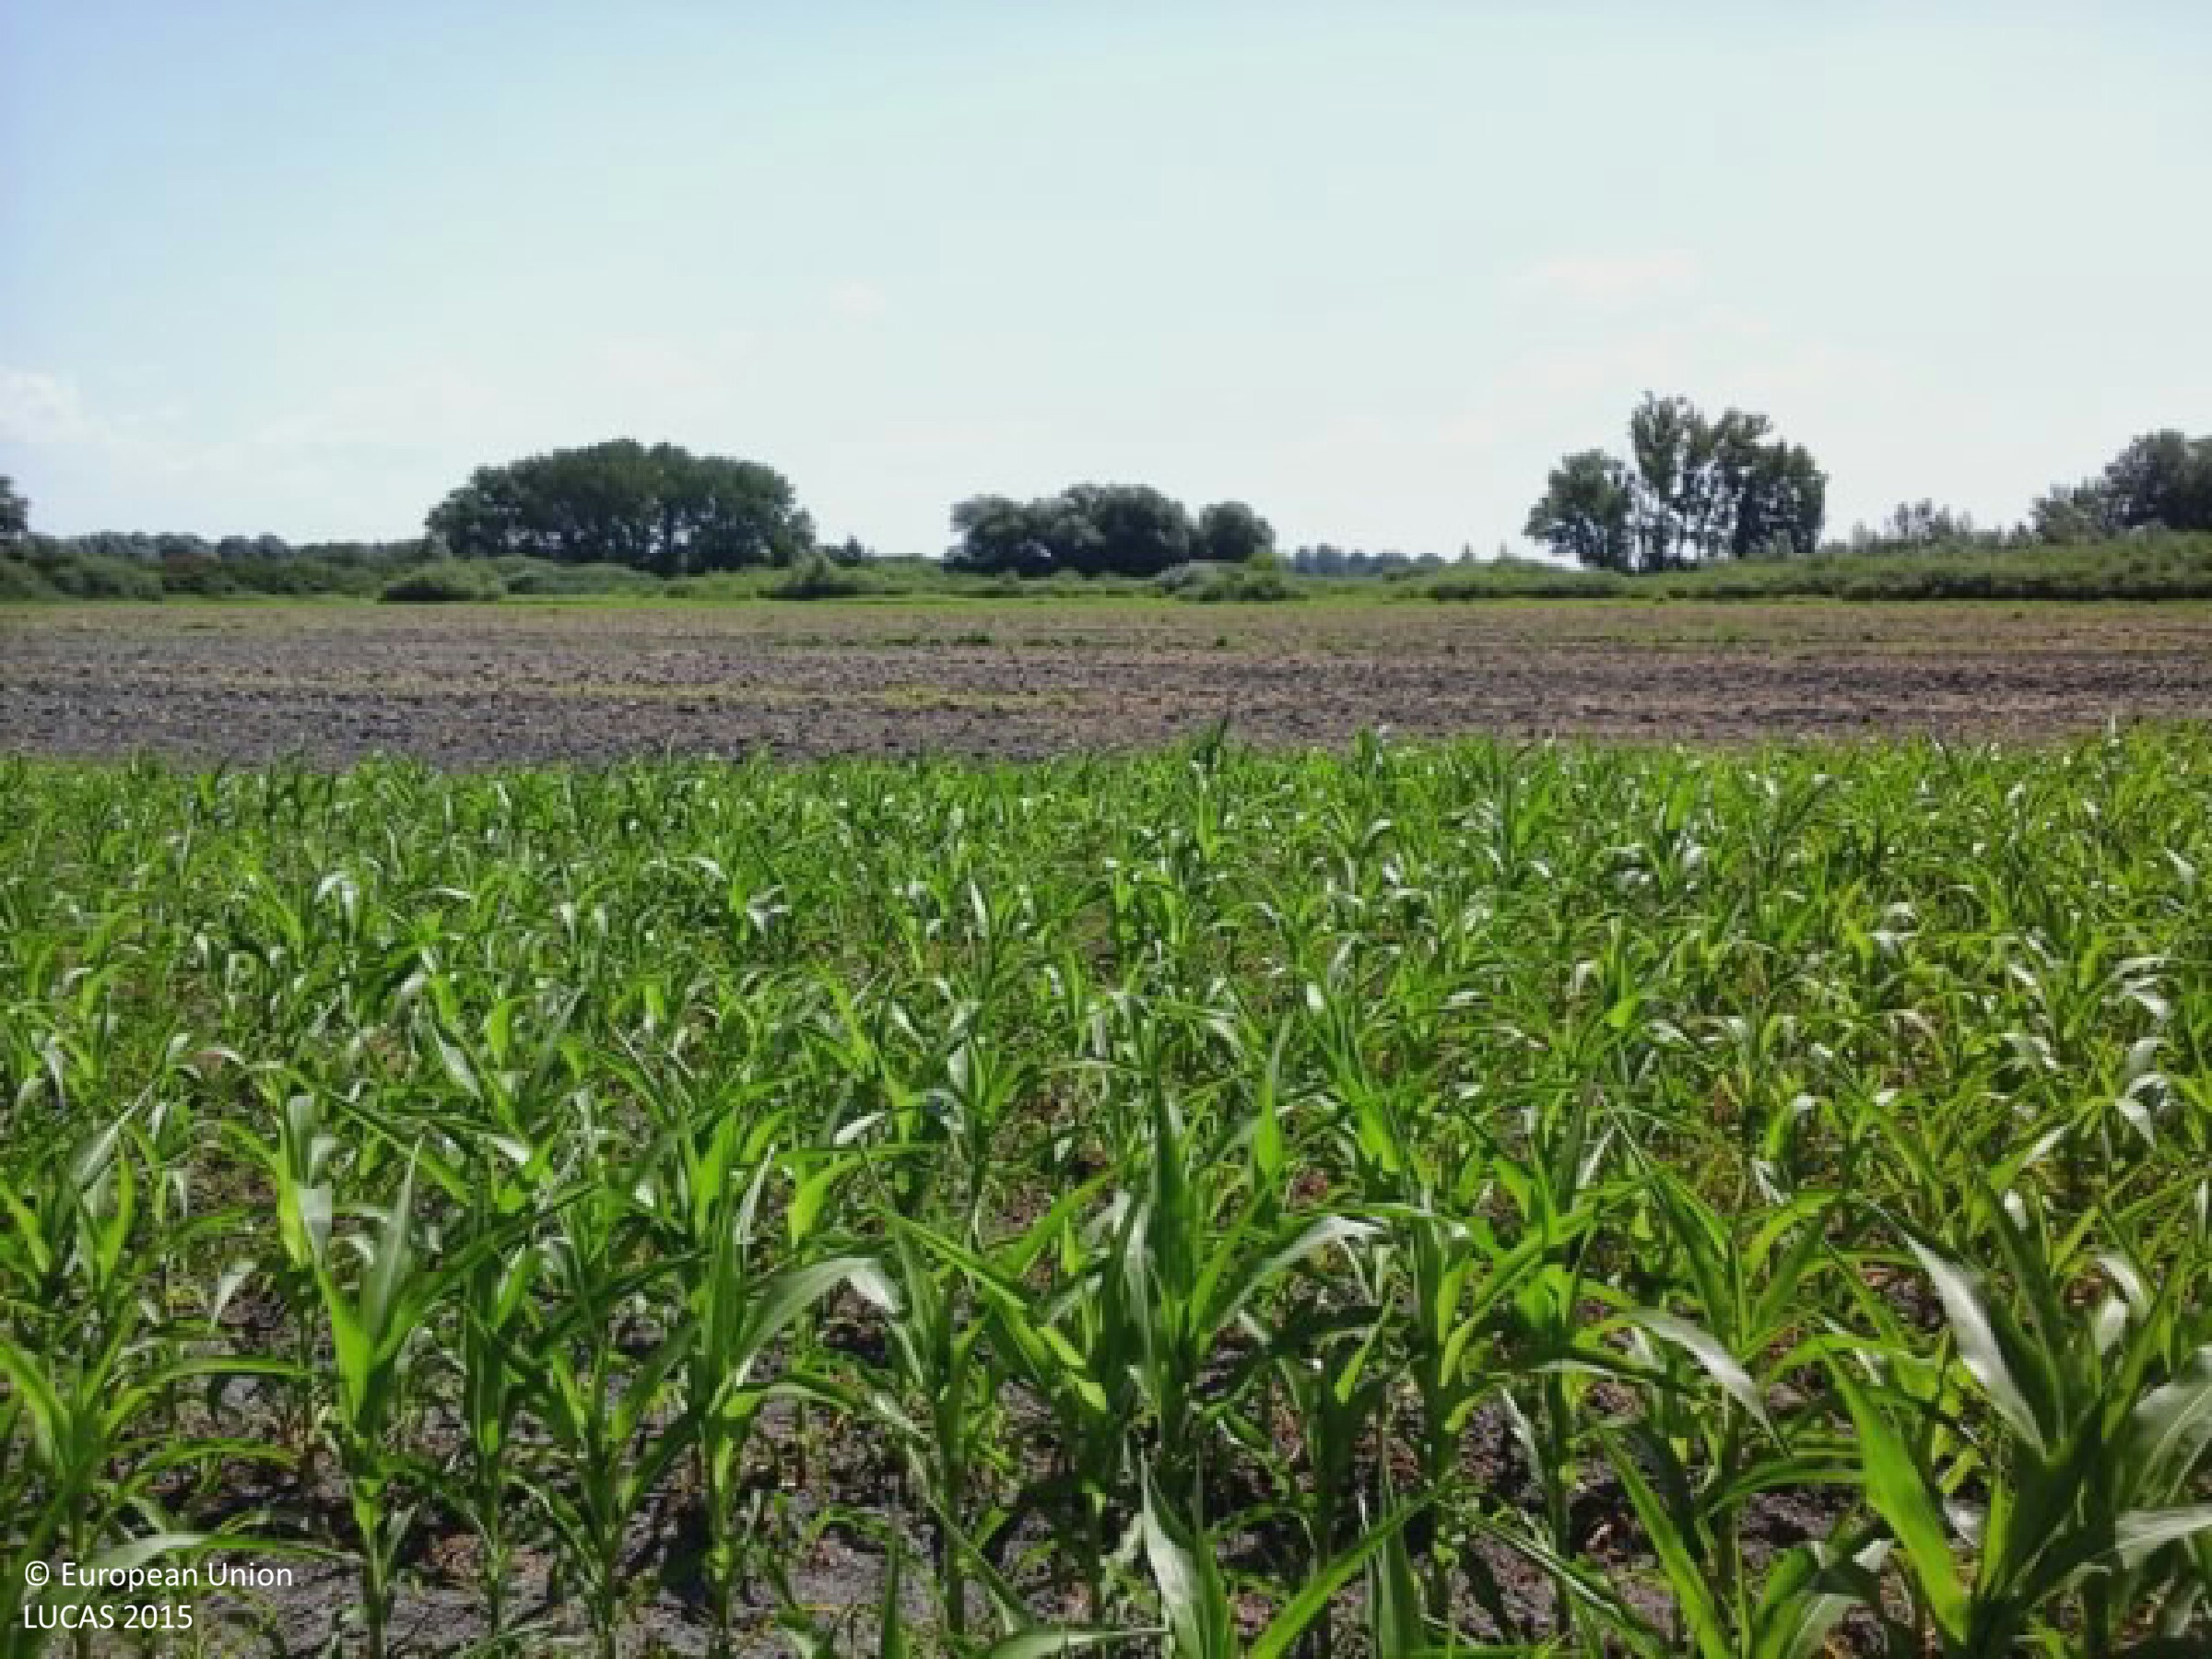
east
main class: Cropland
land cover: Maize
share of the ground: 25 - 50 %
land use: Agriculture (excluding fallow land and kitchen gardens)
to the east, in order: Maize; Other bare soil
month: July
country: HU
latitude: 45.9793
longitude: 18.9042
